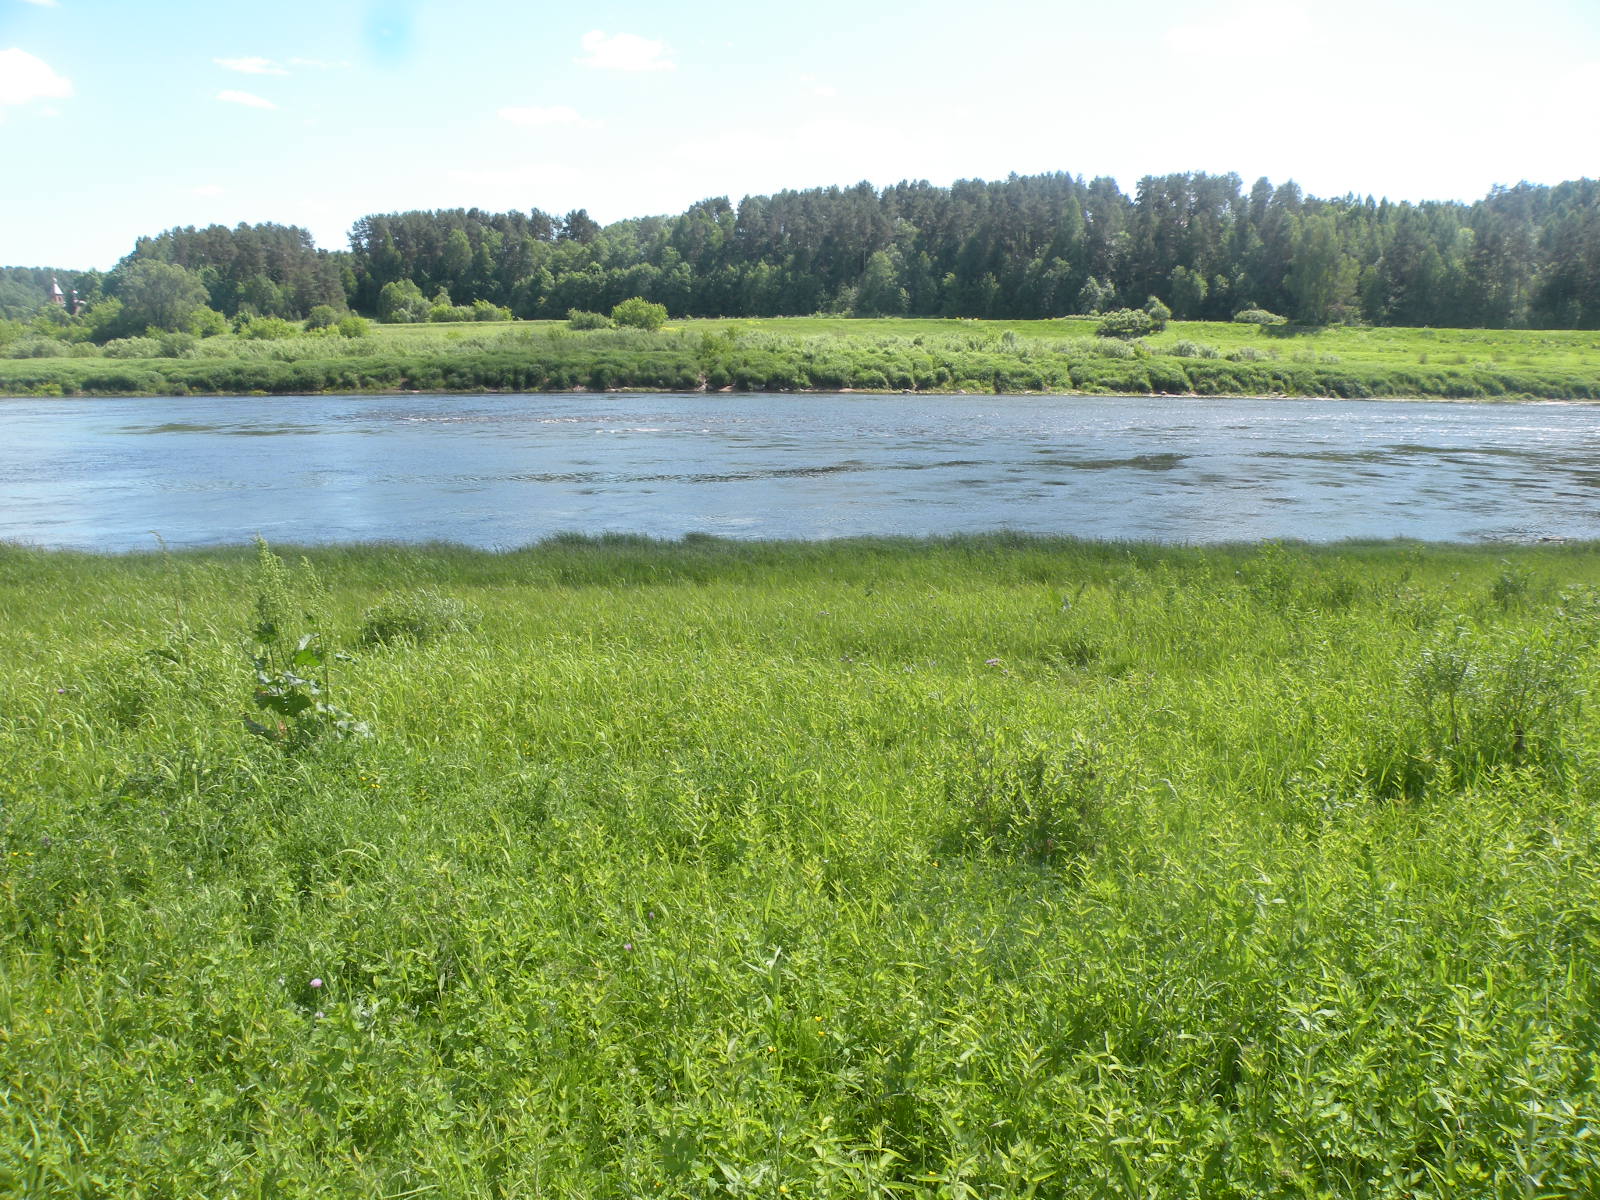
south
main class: Grassland
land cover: Spontaneously vegetated surfaces
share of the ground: > 75 %
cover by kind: herbaceous plants 100 %
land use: Semi-natural and natural areas not in use
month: June
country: LV
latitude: 55.8705
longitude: 26.9941
